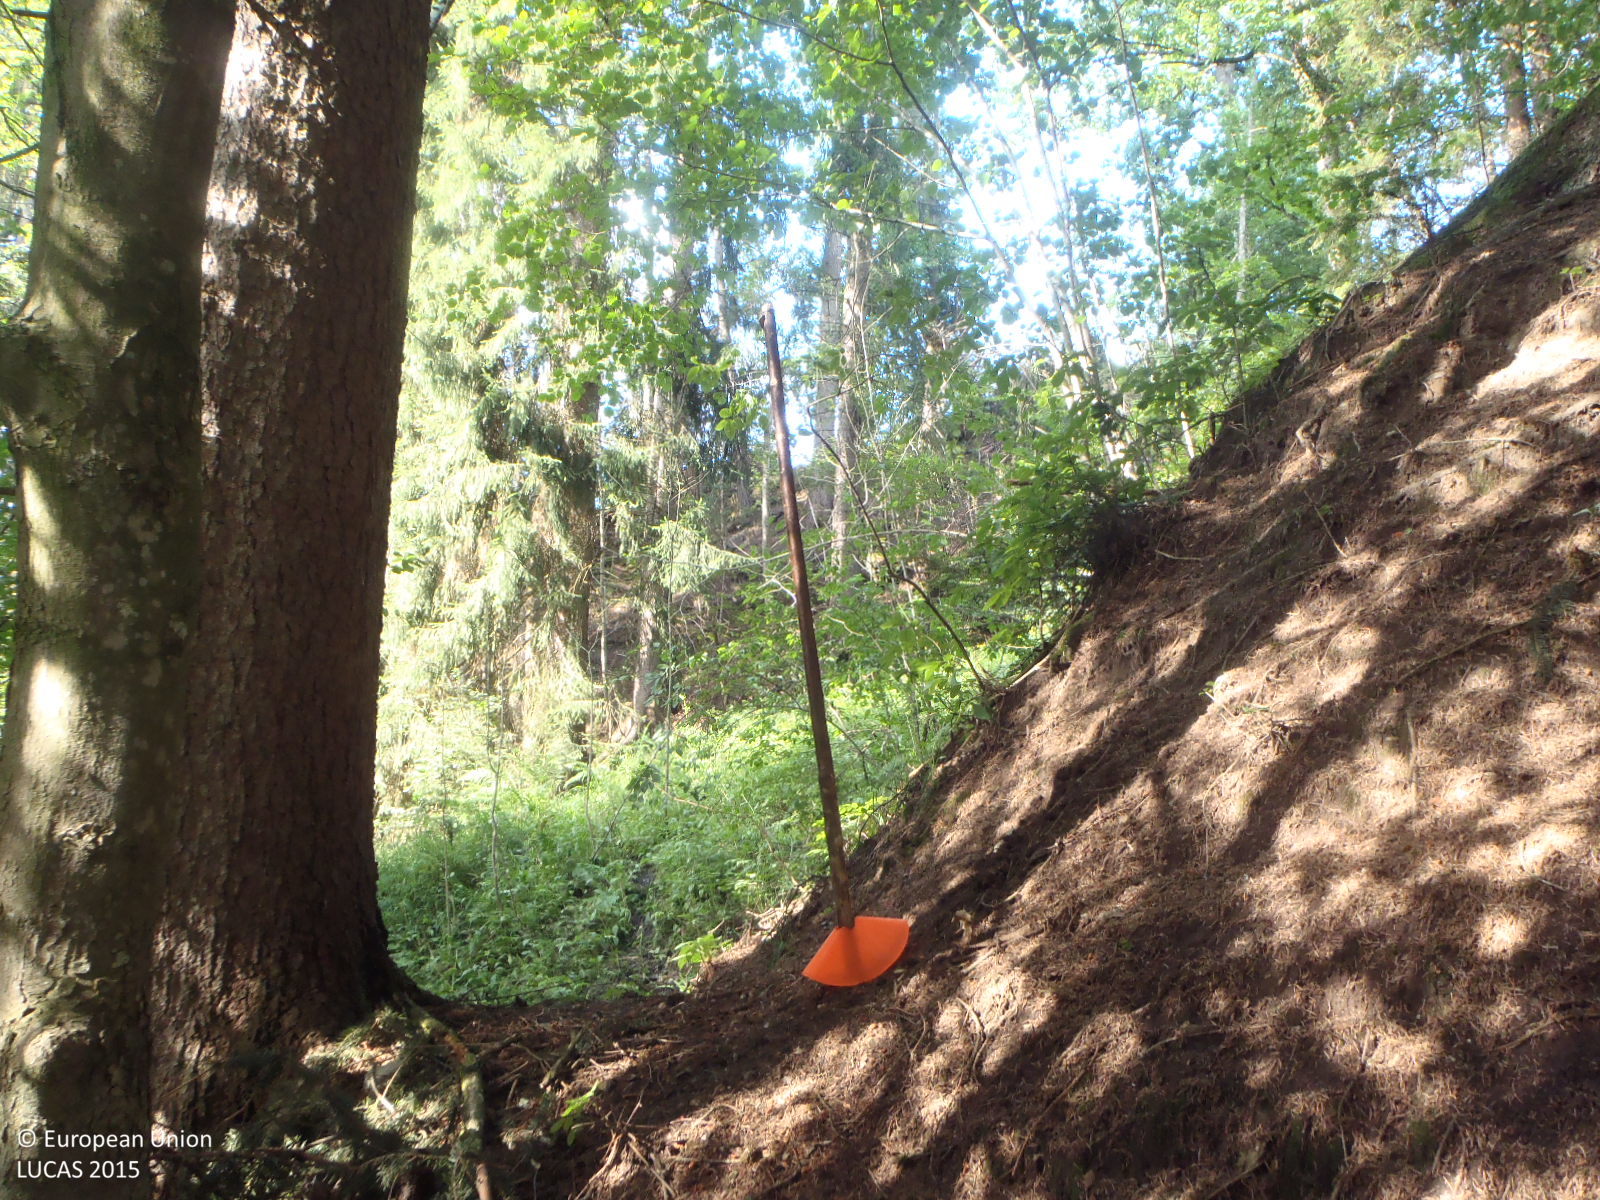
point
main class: Woodland
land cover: Spruce dominated mixed woodland
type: alpine coniferous forest
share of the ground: > 75 %
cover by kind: coniferous forest trees 70 %, broadleaved forest trees 30 %
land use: Forestry
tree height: > 5 m
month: July
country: AT
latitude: 47.4151
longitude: 11.8938
